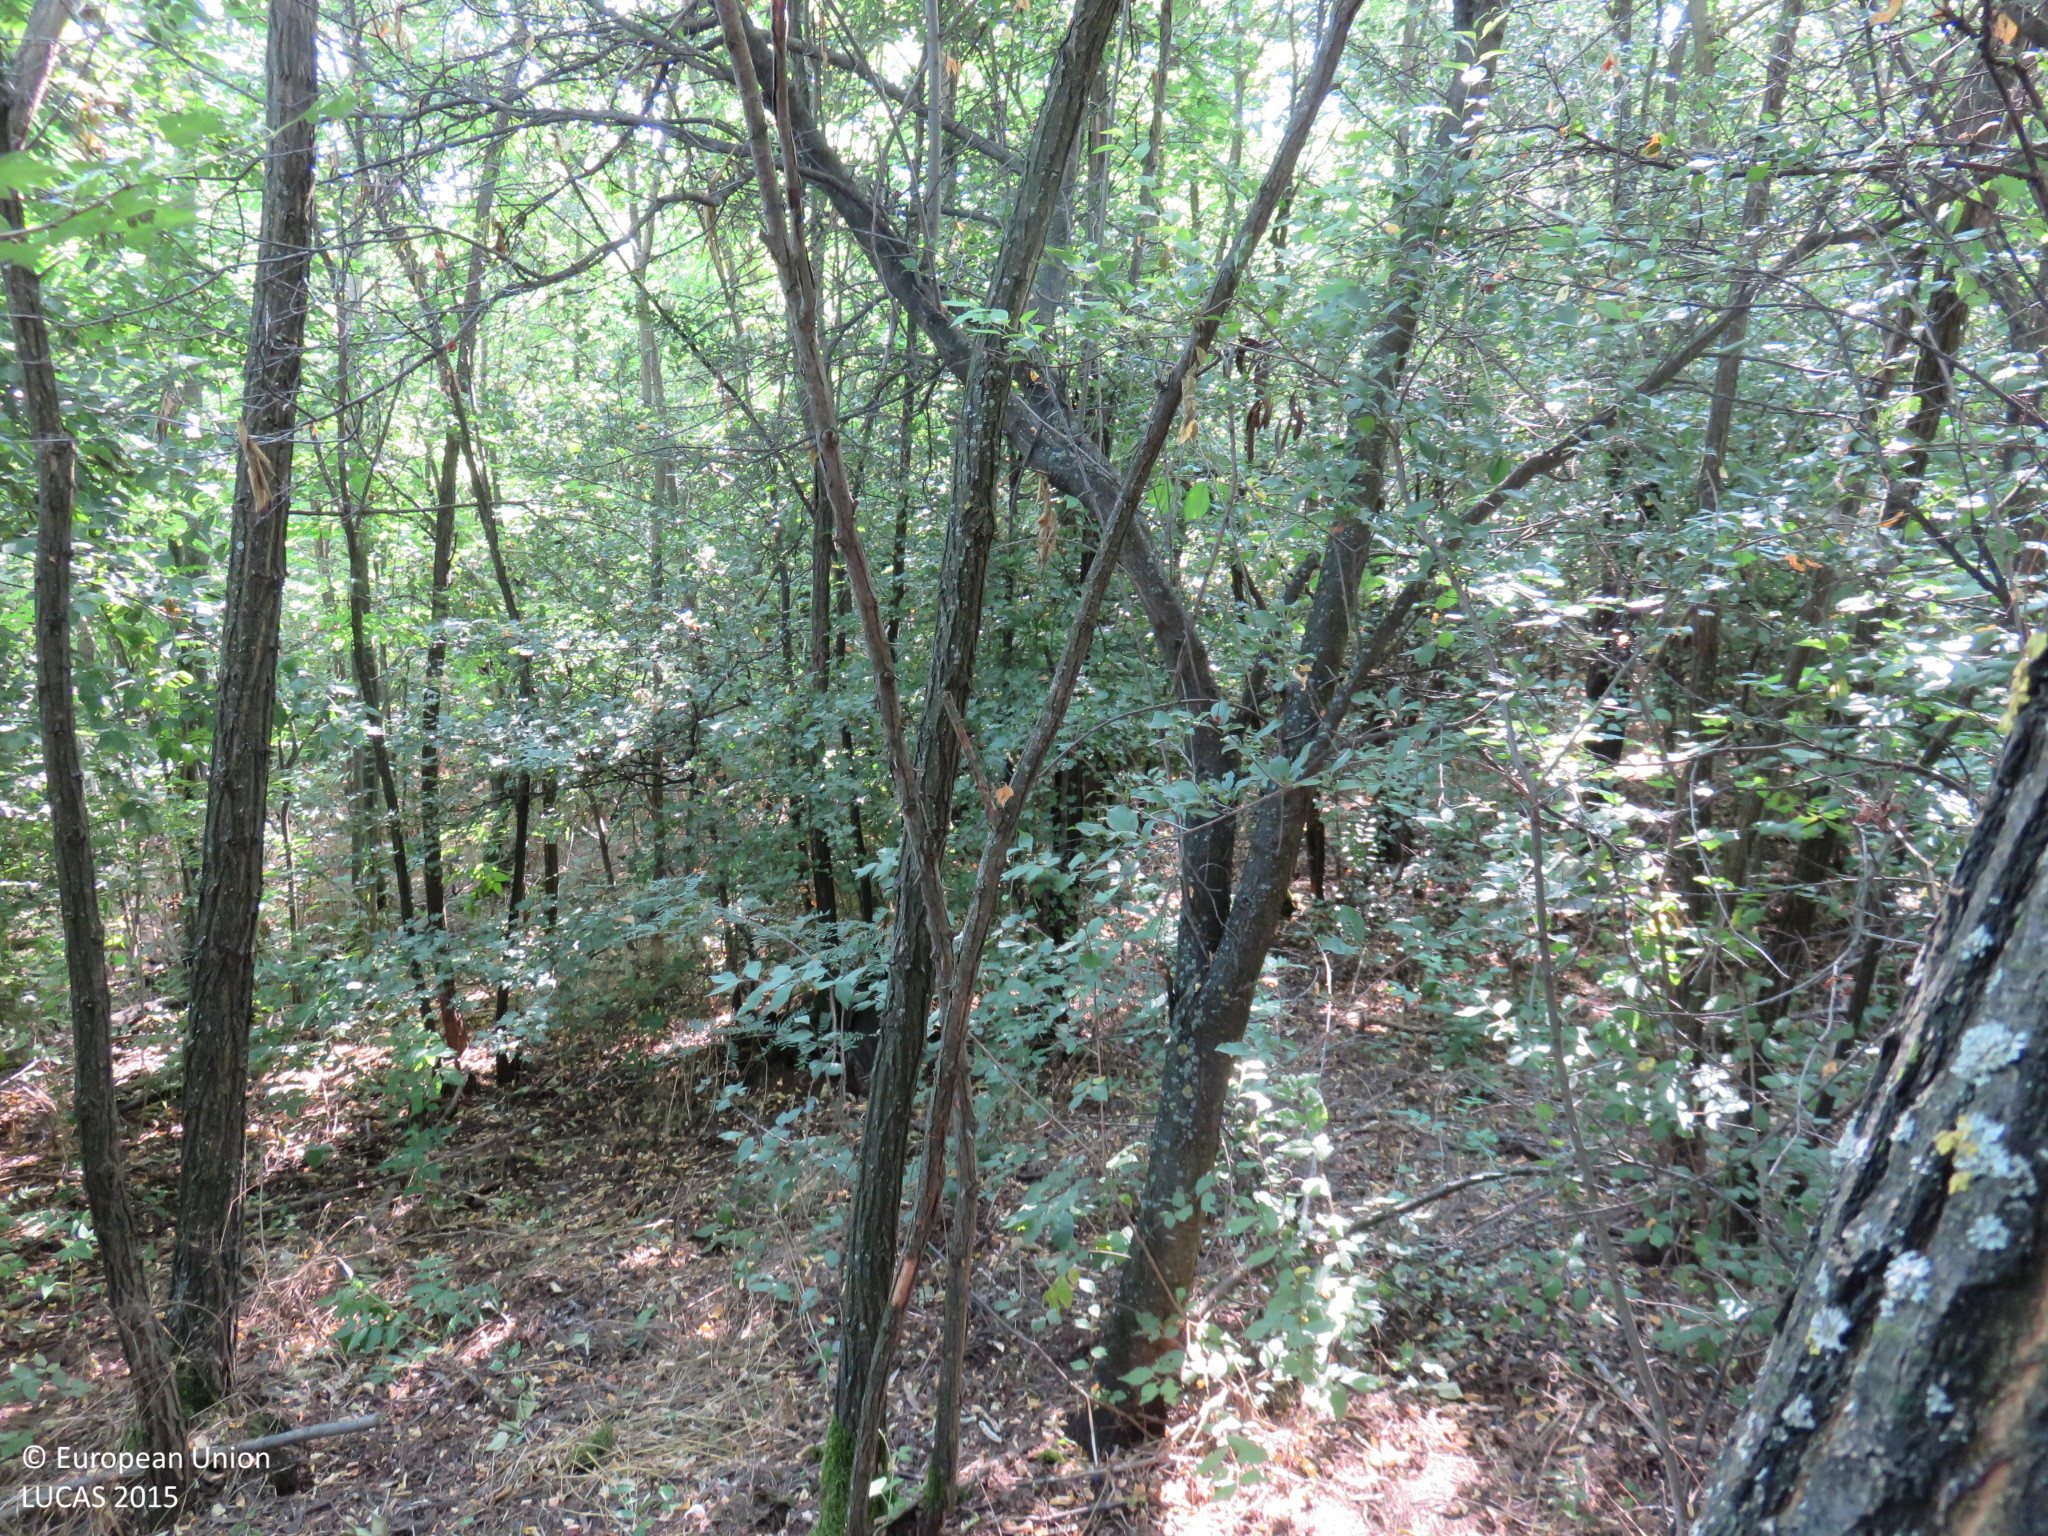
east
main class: Woodland
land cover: Broadleaved woodland
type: mesophytic deciduous forest
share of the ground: > 75 %
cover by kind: broadleaved forest trees 95 %, shrubs 5 %
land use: Forestry
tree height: > 5 m
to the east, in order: Broadleaved woodland
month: July
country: BG
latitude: 43.5228
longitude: 25.1562
